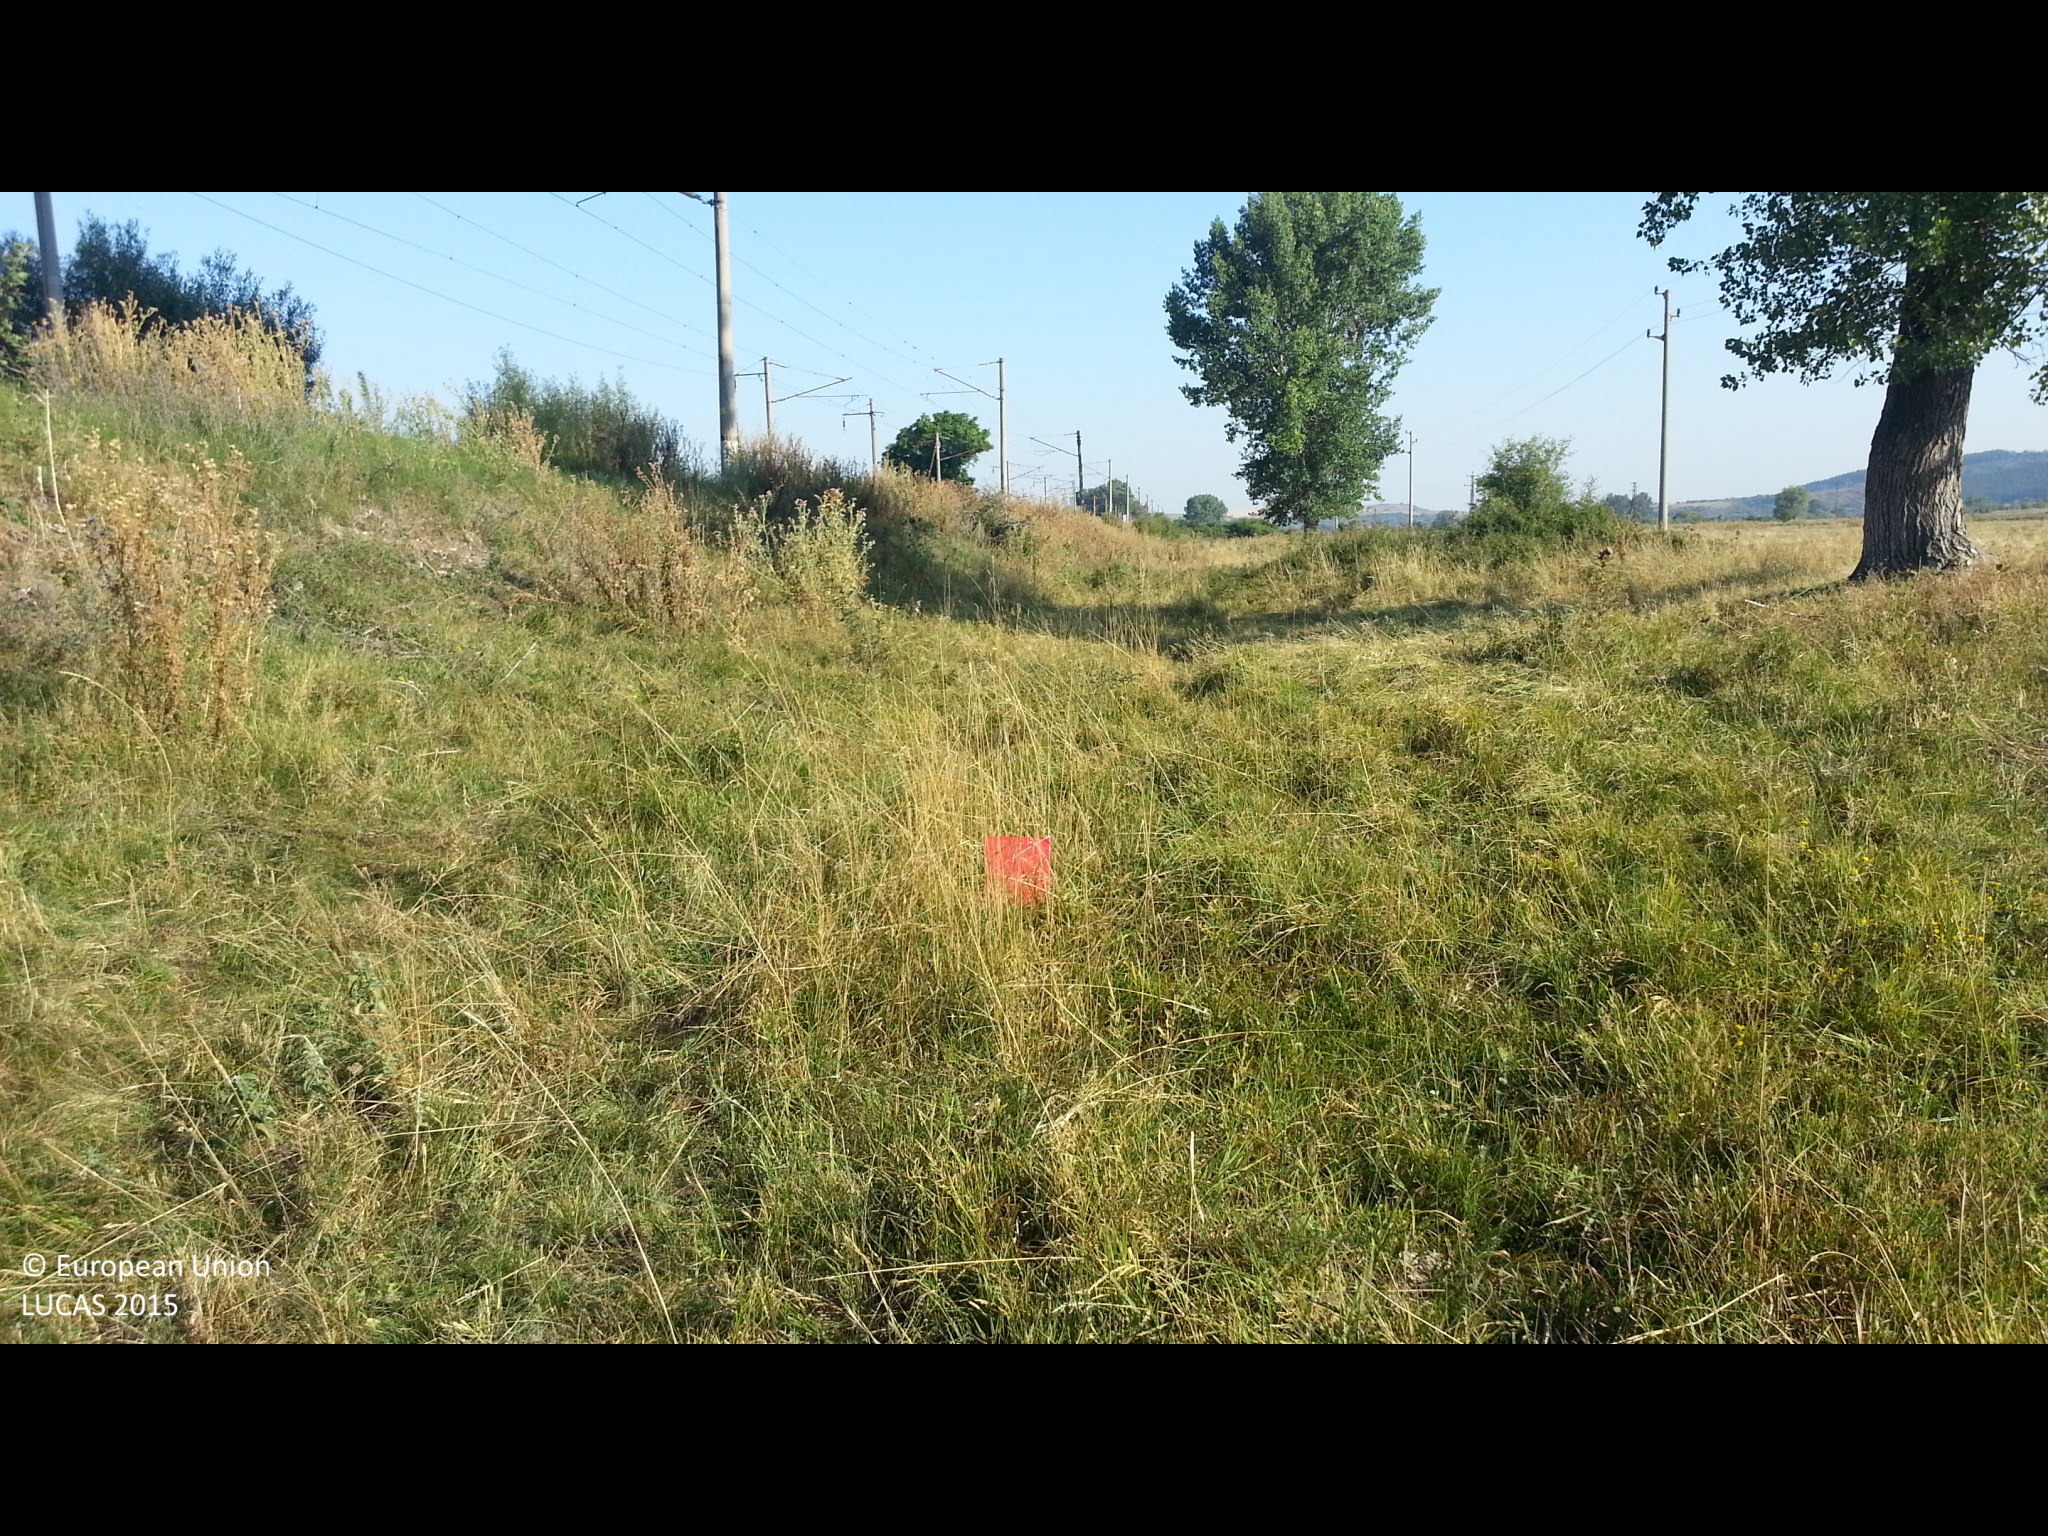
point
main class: Grassland
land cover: Grassland with sparse tree/shrub cover
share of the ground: > 75 %
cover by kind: herbaceous plants 95 %, broadleaved forest trees 5 %
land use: Agriculture (excluding fallow land and kitchen gardens)
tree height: > 5 m
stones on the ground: < 10 %
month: August
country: BG
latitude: 42.5496
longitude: 22.9487
